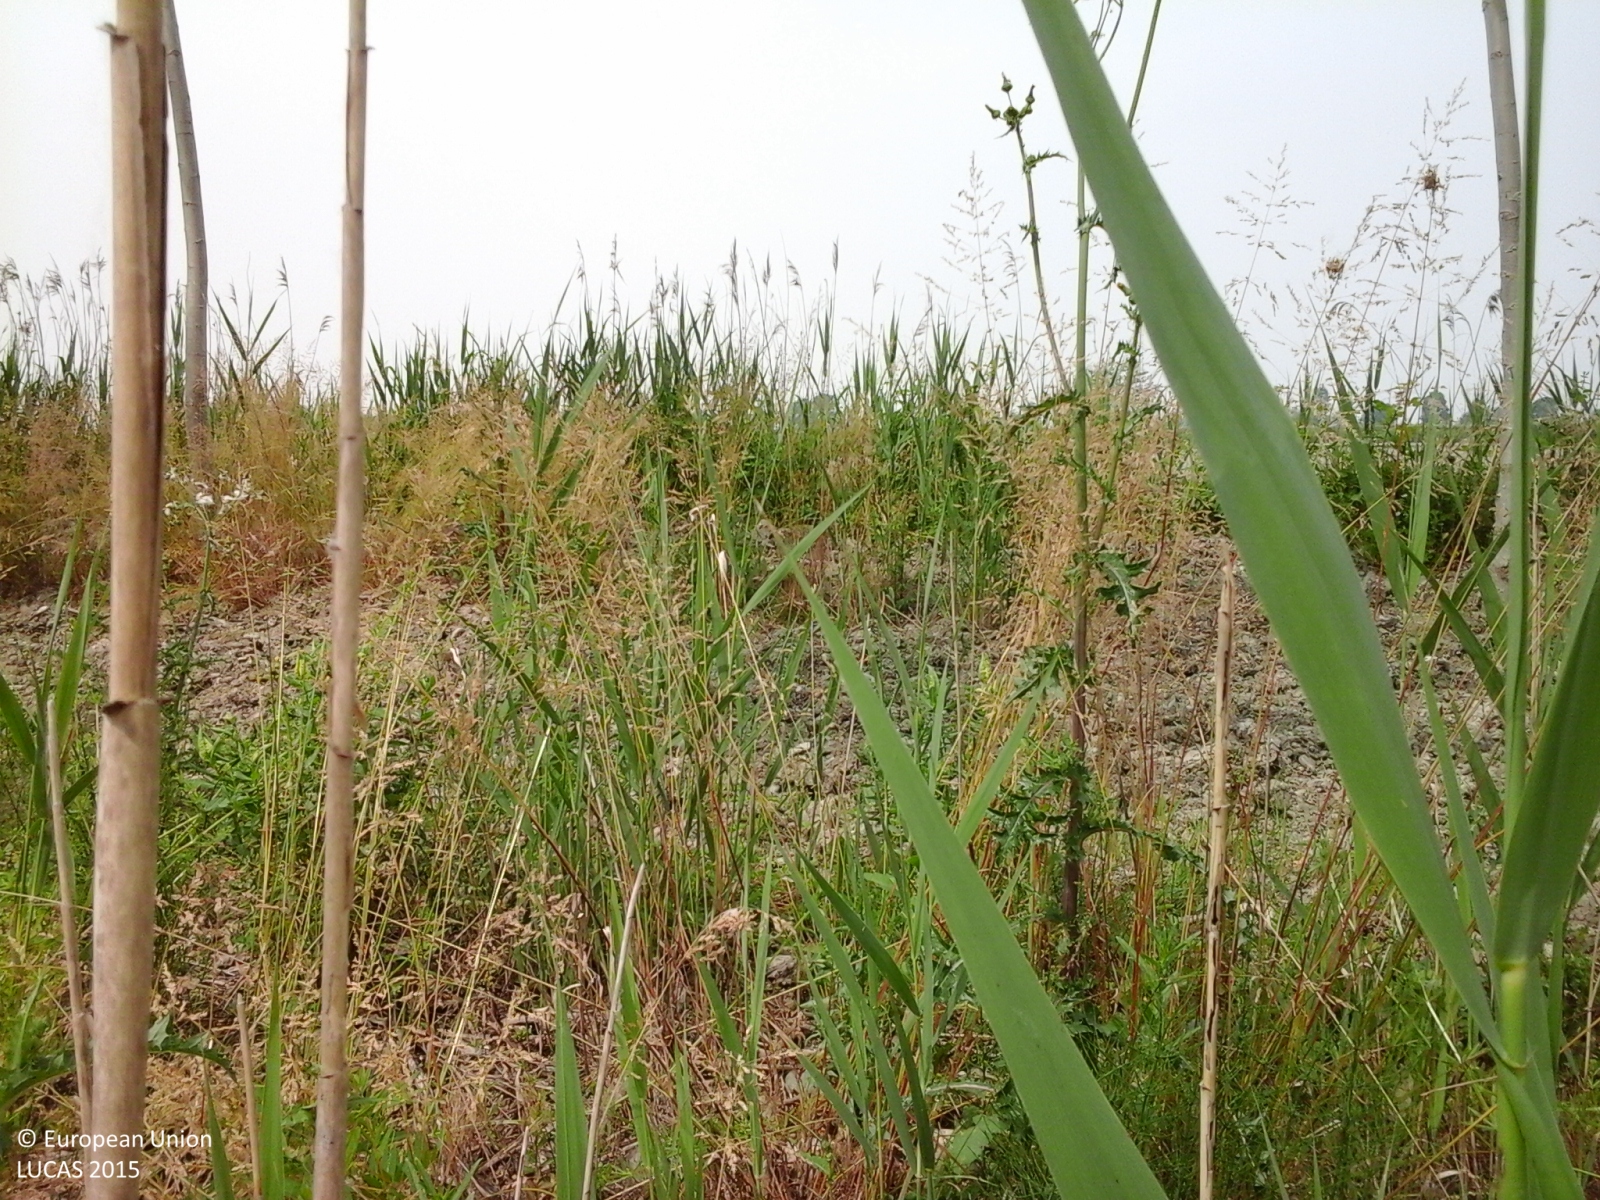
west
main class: Woodland
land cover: Broadleaved woodland
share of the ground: 50 - 75 %
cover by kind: broadleaved forest trees 60 %, shrubs 40 %
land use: Forestry
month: May
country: IT
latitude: 45.1875
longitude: 8.5136
